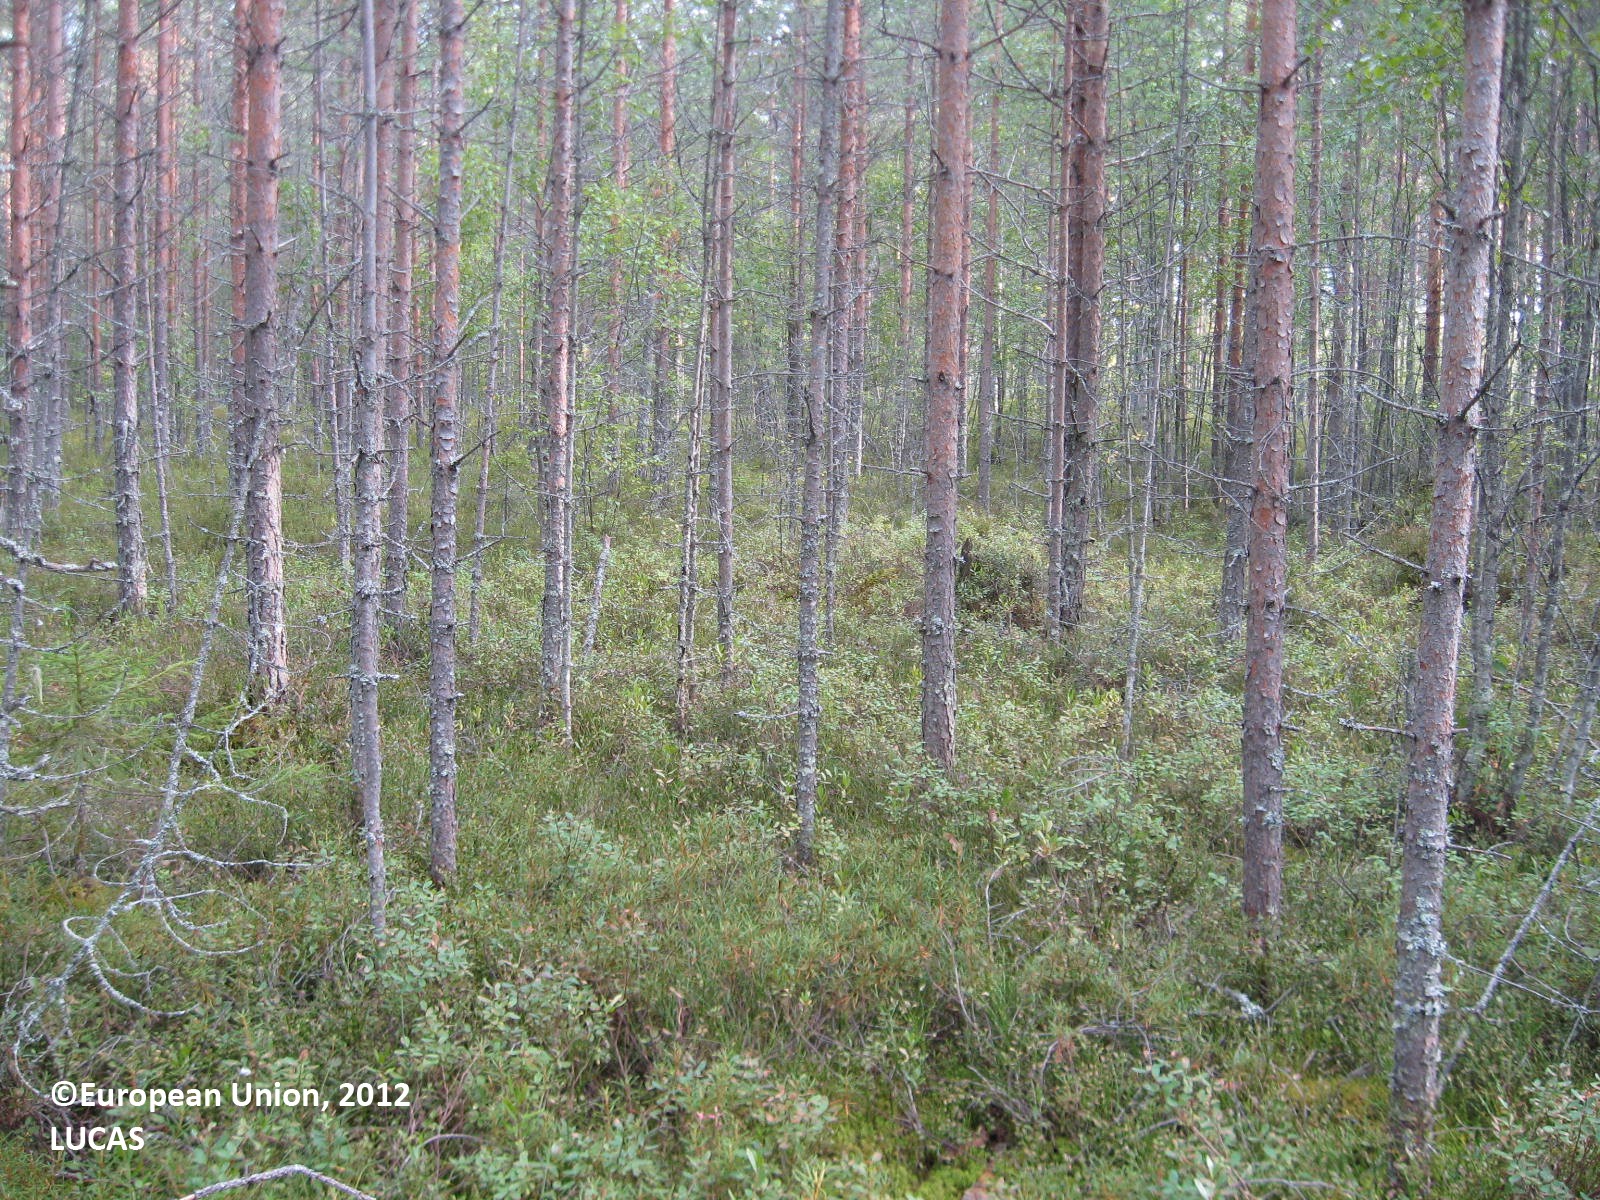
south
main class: Woodland
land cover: Pine dominated coniferous woodland
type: boreal forest
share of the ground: > 75 %
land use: Forestry
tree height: > 5 m
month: August
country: FI
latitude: 63.4198
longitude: 30.1468
